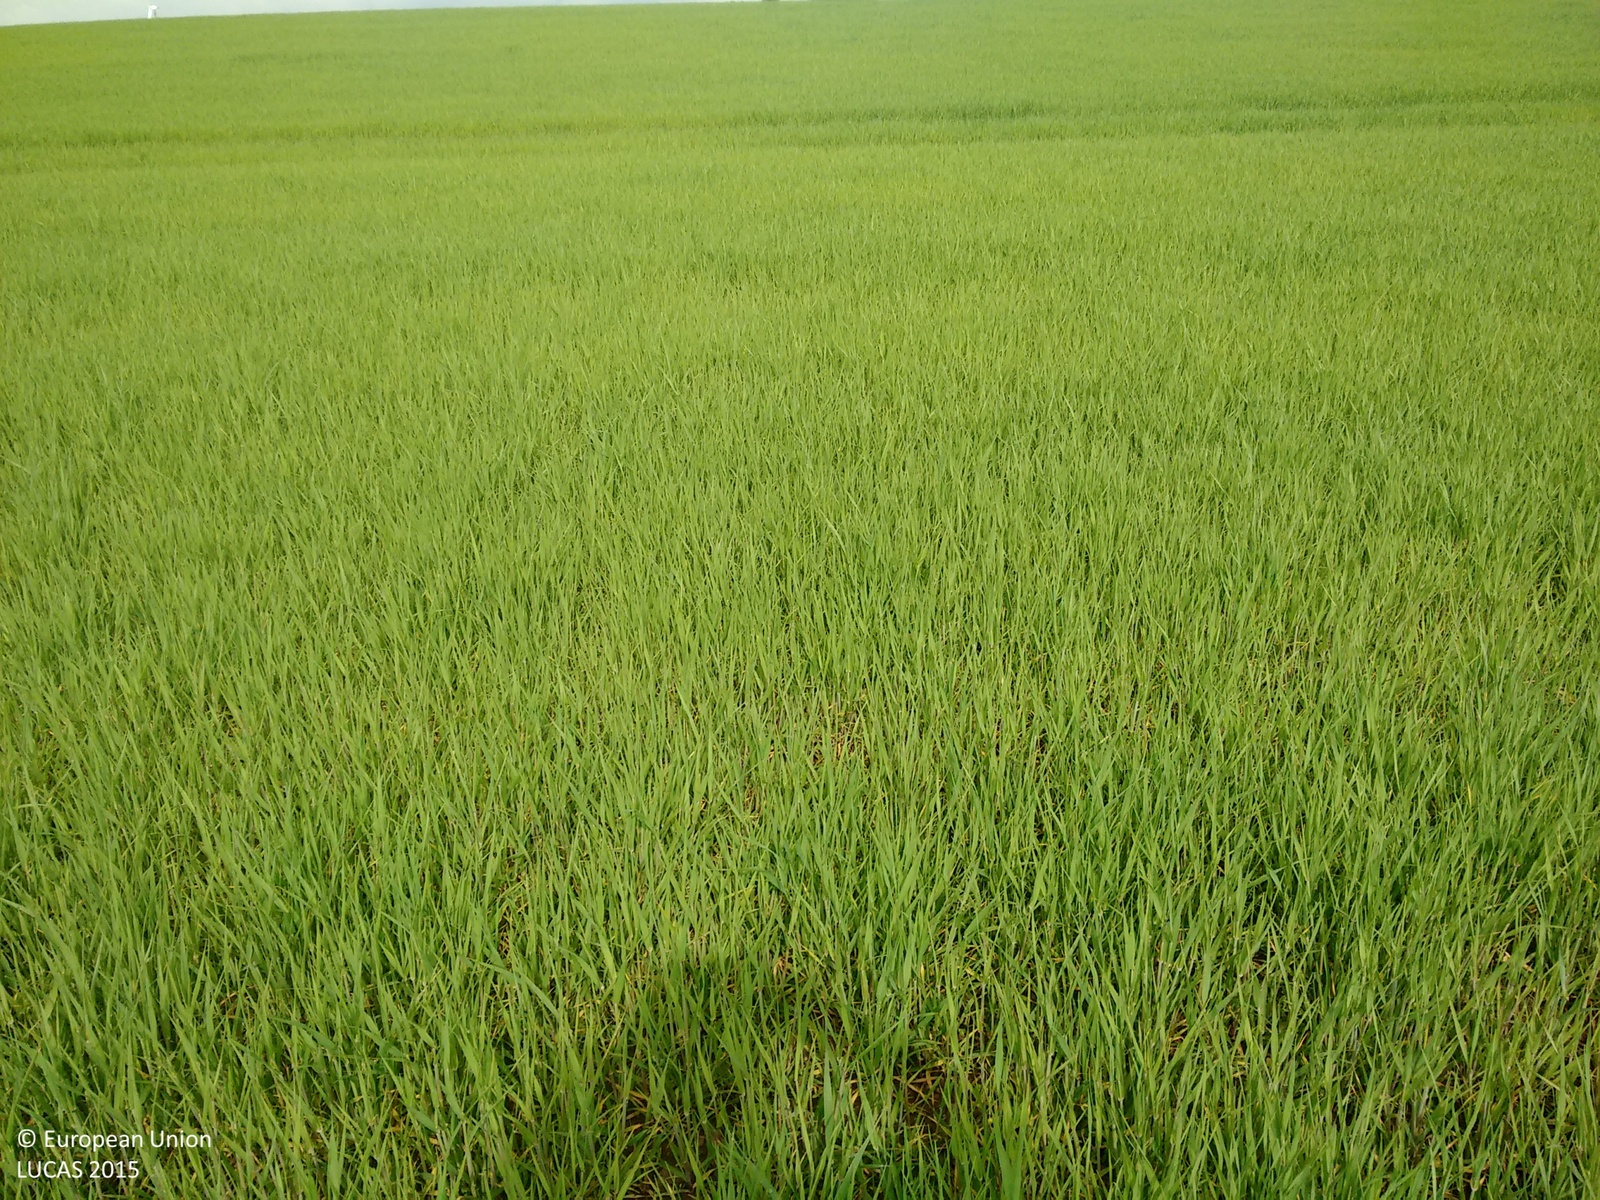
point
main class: Cropland
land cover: Barley
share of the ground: > 75 %
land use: Agriculture (excluding fallow land and kitchen gardens)
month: June
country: GB
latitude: 56.2520
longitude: -3.3566
